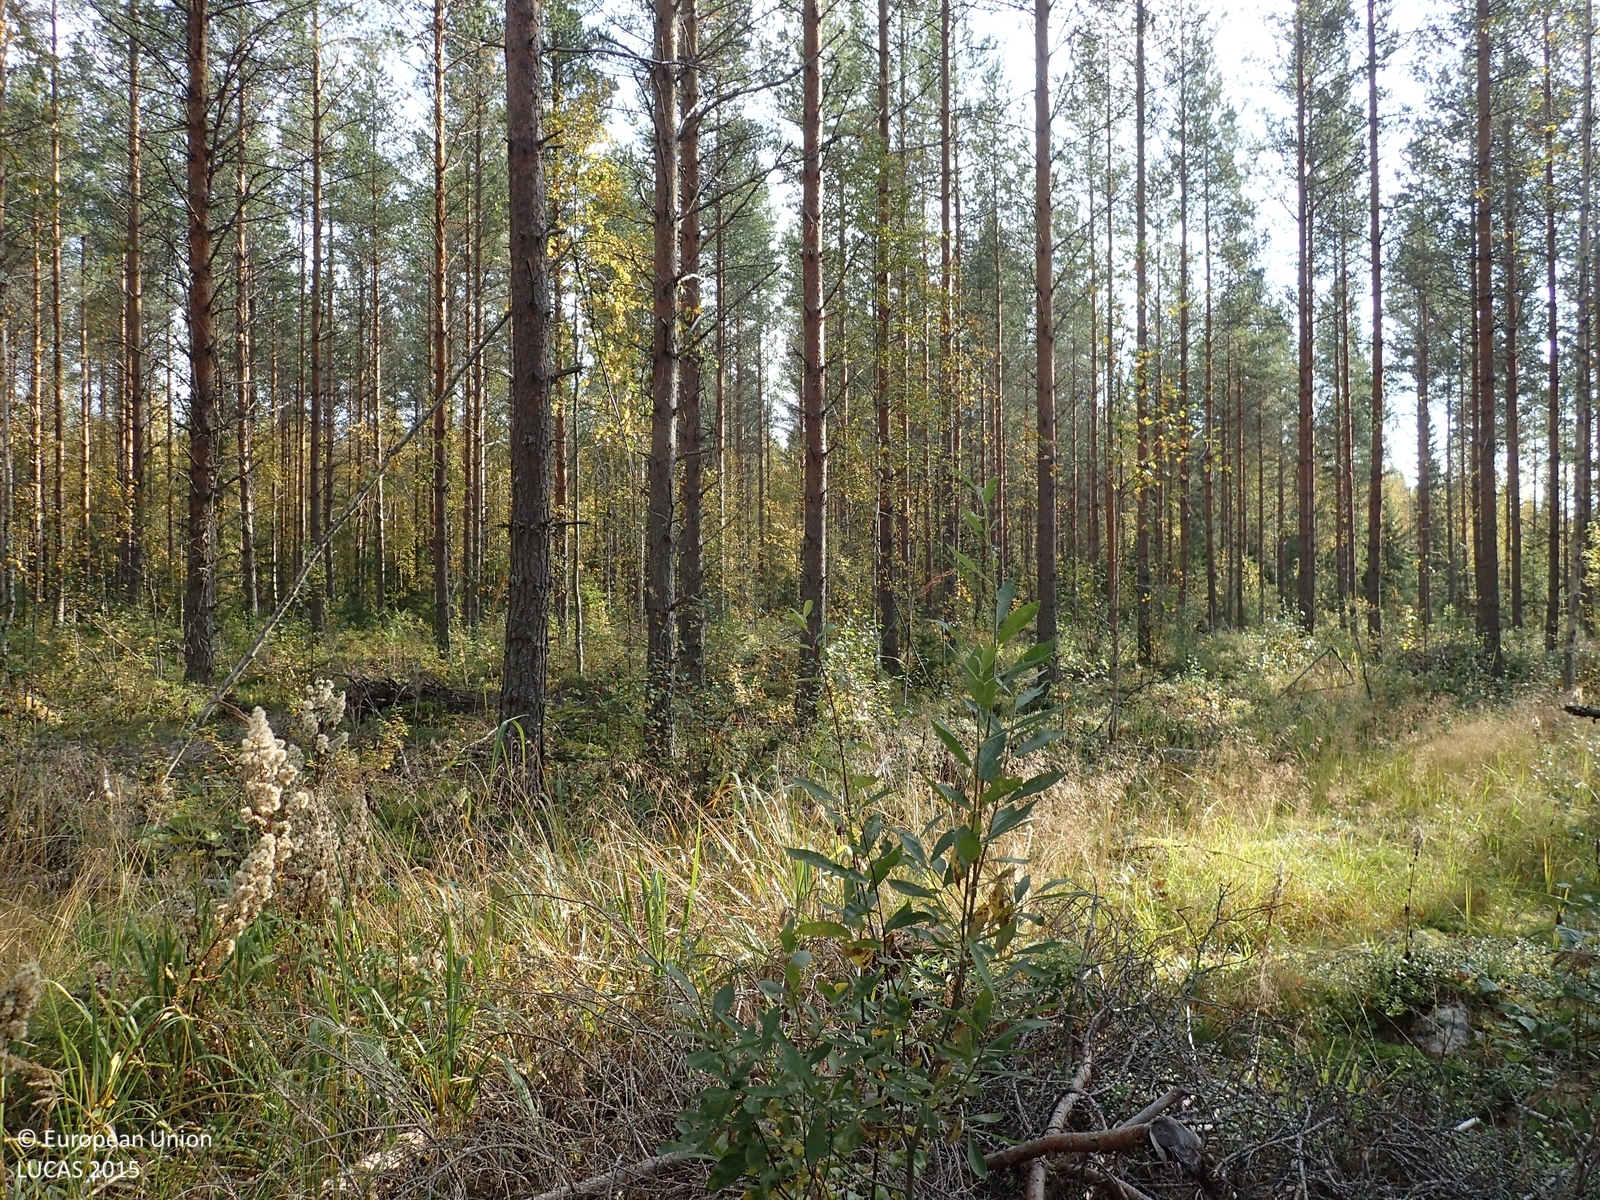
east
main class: Woodland
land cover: Pine dominated mixed woodland
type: boreal forest
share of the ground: > 75 %
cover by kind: coniferous forest trees 55 %, broadleaved forest trees 20 %, shrubs 15 %, herbaceous plants 5 %, lichens and mosses 5 %
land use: Forestry
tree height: > 5 m
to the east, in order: Pine dominated mixed woodland; Ditches and canals; Pine dominated mixed woodland; Ditches and canals; Pine dominated mixed woodland; Ditches and canals; Spruce dominated mixed woodland; Ditches and canals; Spruce dominated mixed woodland; Ditches and canals; Spruce dominated mixed woodland; Pine dominated mixed woodland
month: September
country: FI
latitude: 62.9910
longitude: 25.6033
